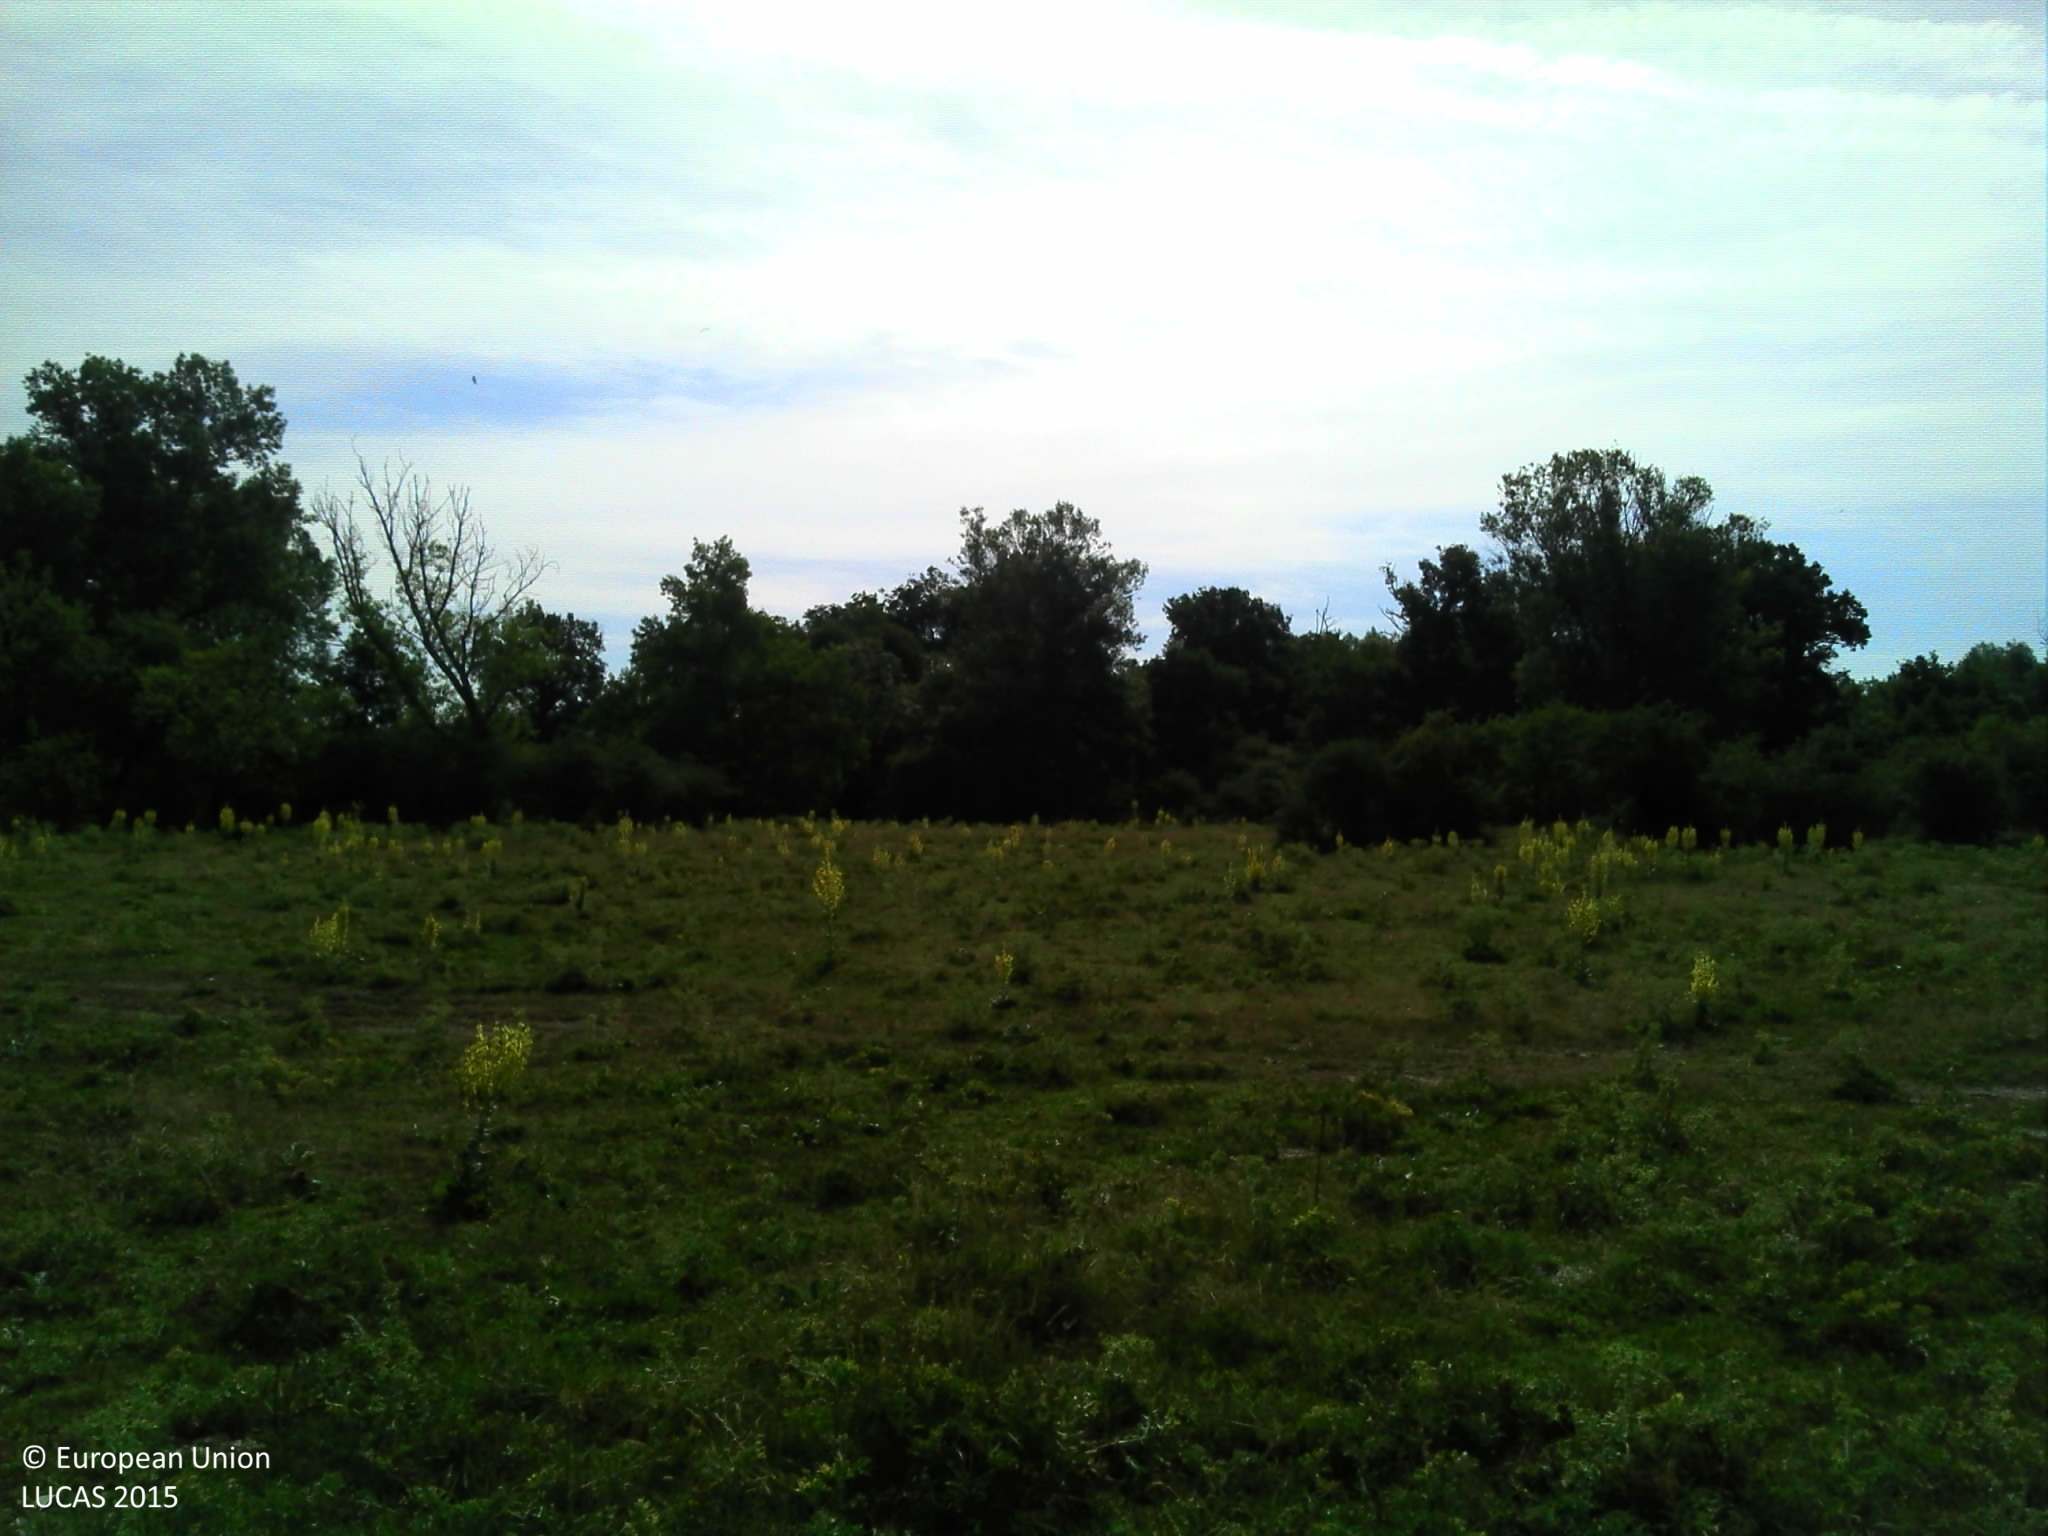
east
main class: Grassland
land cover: Grassland without tree/shrub cover
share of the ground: > 75 %
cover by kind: herbaceous plants 95 %, shrubs 5 %
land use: Agriculture (excluding fallow land and kitchen gardens)
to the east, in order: Grassland without tree/shrub cover; Tracks; Grassland without tree/shrub cover; Broadleaved woodland; Grassland without tree/shrub cover; Fences; Grassland without tree/shrub cover; Broadleaved woodland; Grassland without tree/shrub cover; Broadleaved woodland; Inland marshes
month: June
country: FR
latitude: 46.3599
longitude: 3.3313
